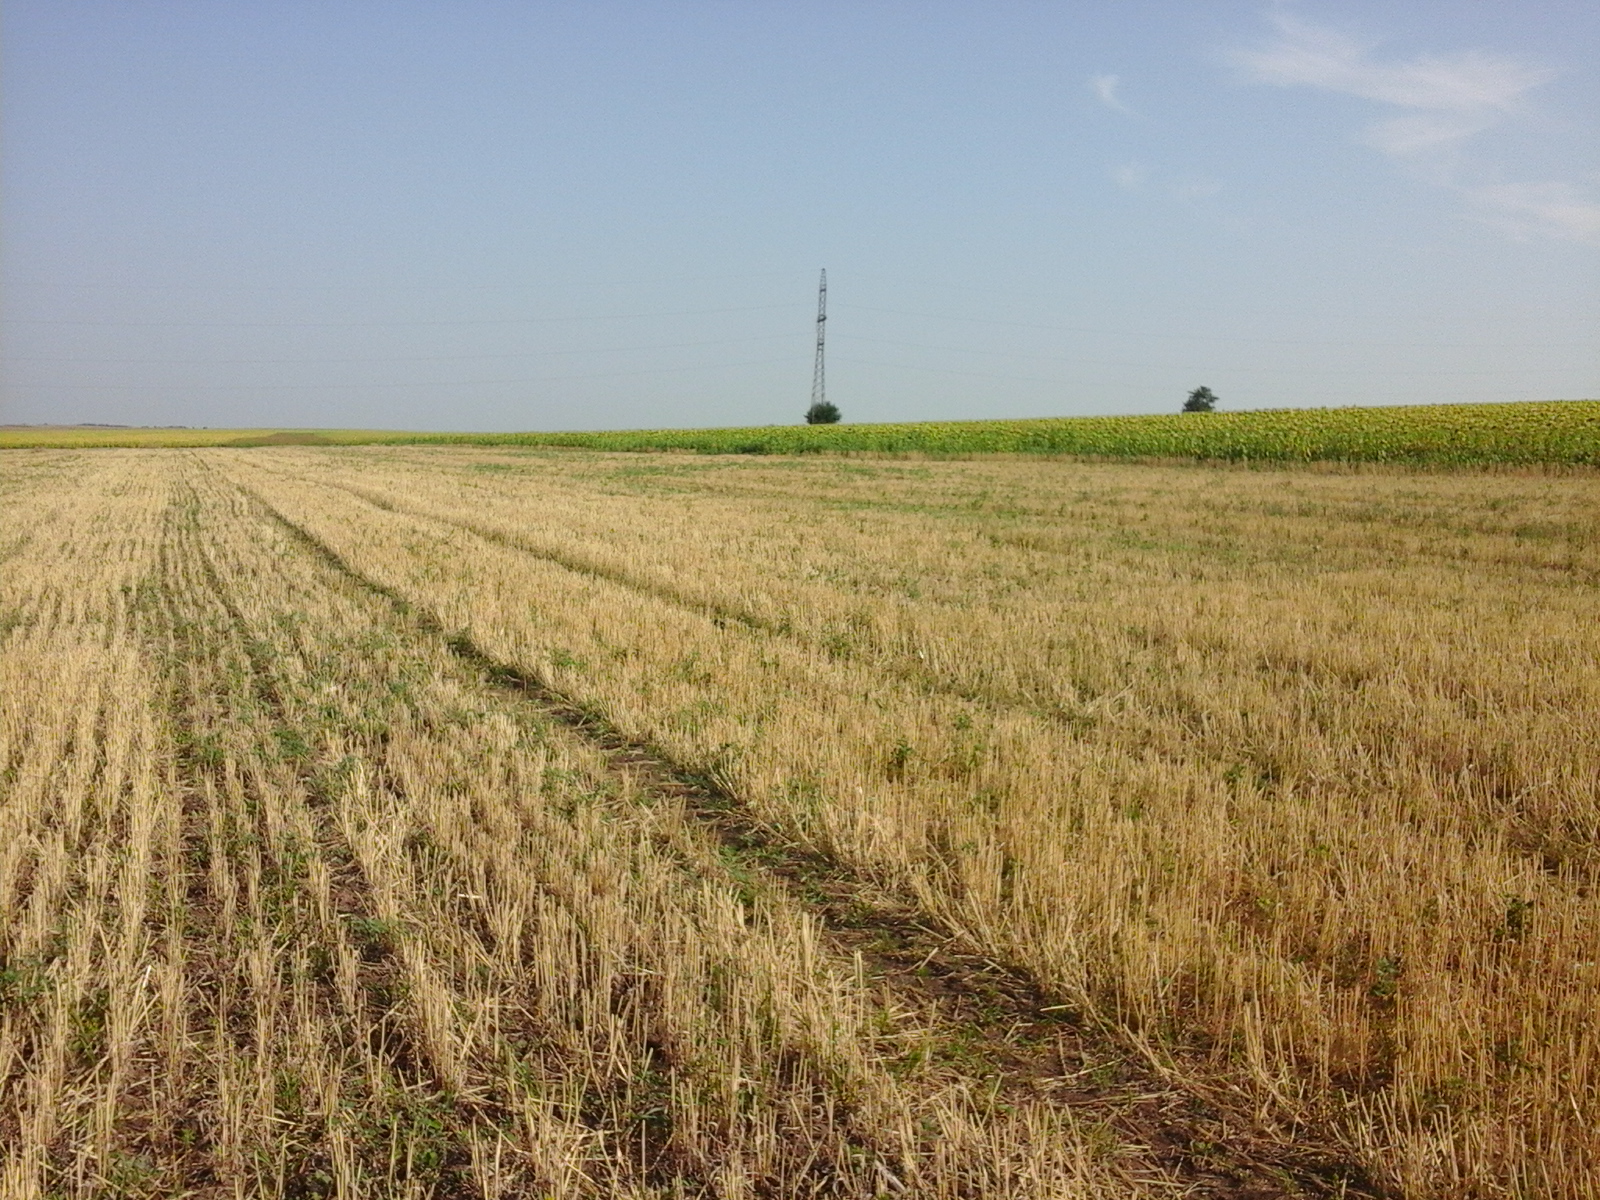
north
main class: Cropland
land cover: Common wheat
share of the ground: > 75 %
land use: Agriculture (excluding fallow land and kitchen gardens)
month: August
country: RO
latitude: 45.8076
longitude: 27.5423
